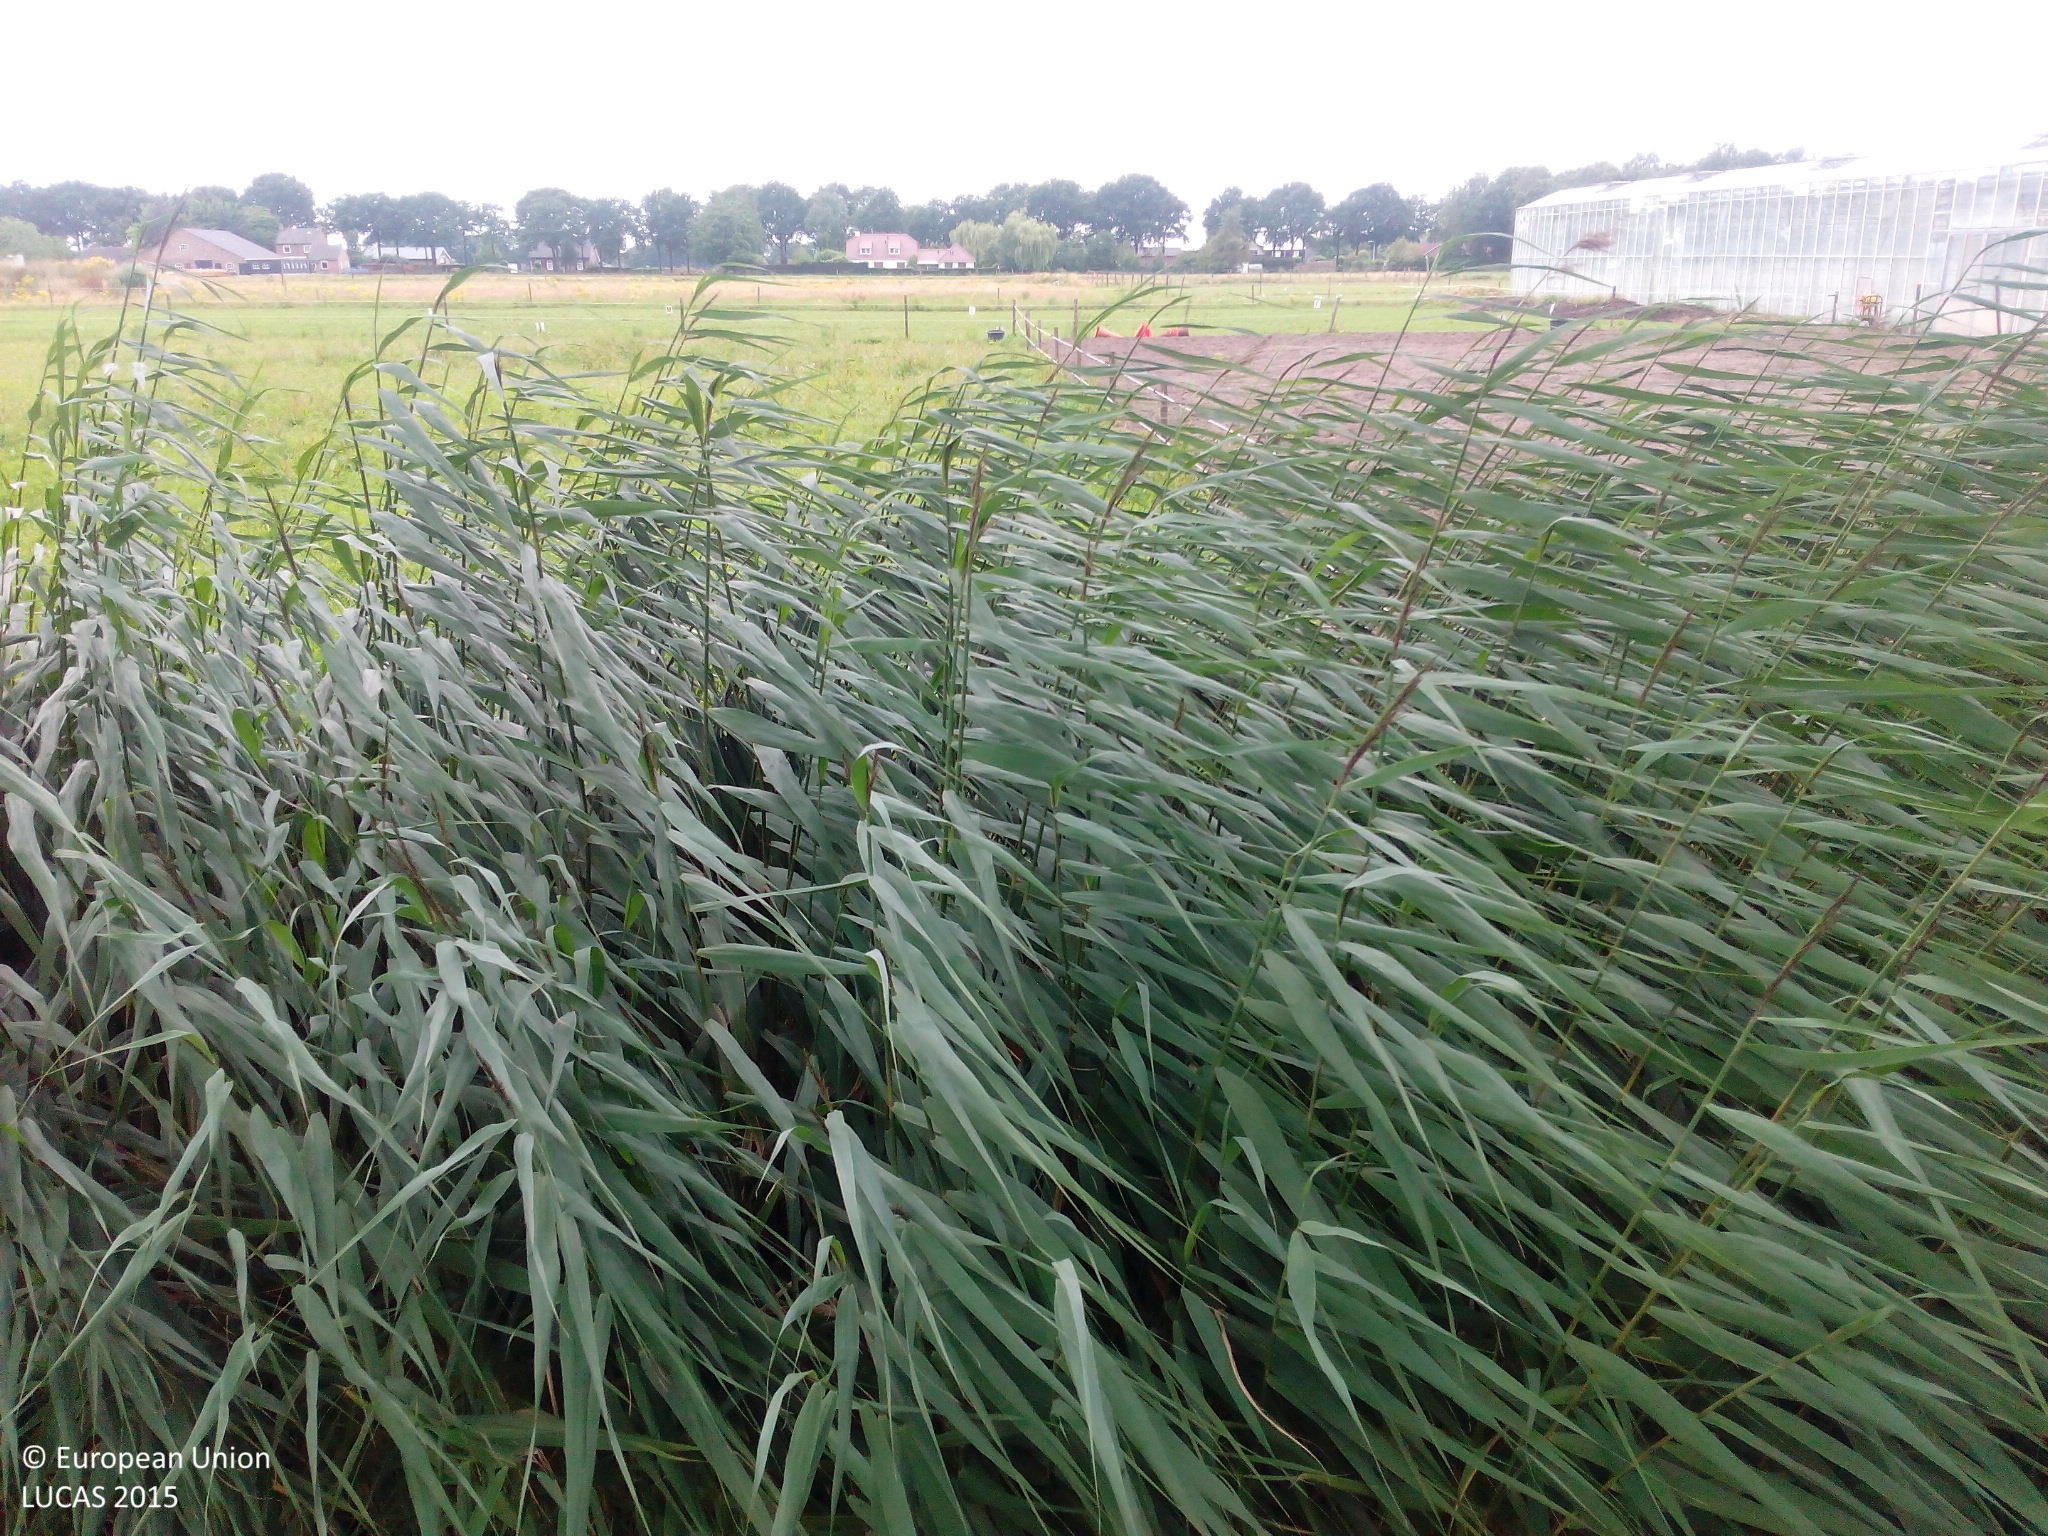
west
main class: Grassland
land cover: Grassland without tree/shrub cover
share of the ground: > 75 %
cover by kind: herbaceous plants 100 %
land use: Amenities, museums, leisure
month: July
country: NL
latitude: 51.5925
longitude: 4.6988
